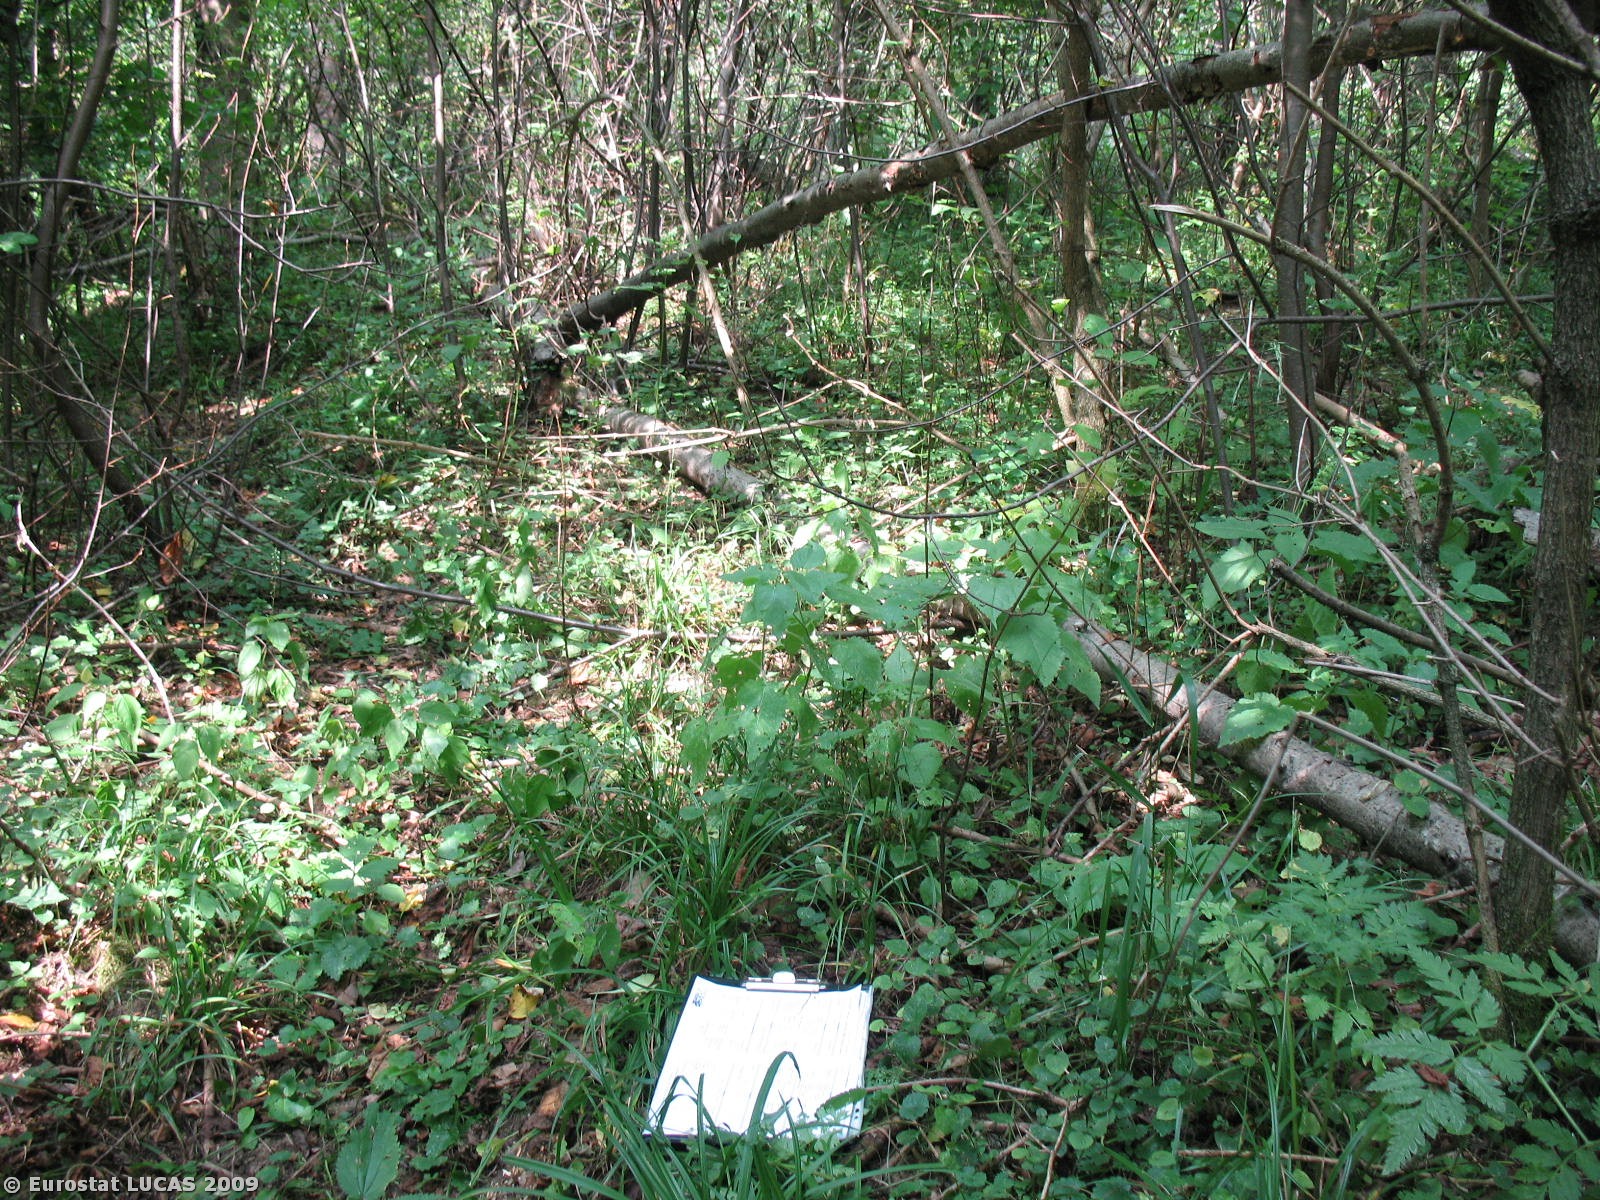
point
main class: Woodland
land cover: Mixed woodland
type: hemiboreal forest and nemoral coniferous forest and mixed broadleaved-coniferous forest
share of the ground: > 75 %
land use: Forestry
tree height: > 5 m
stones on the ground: < 10 %
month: August
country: PL
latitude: 49.3157
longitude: 22.4577
